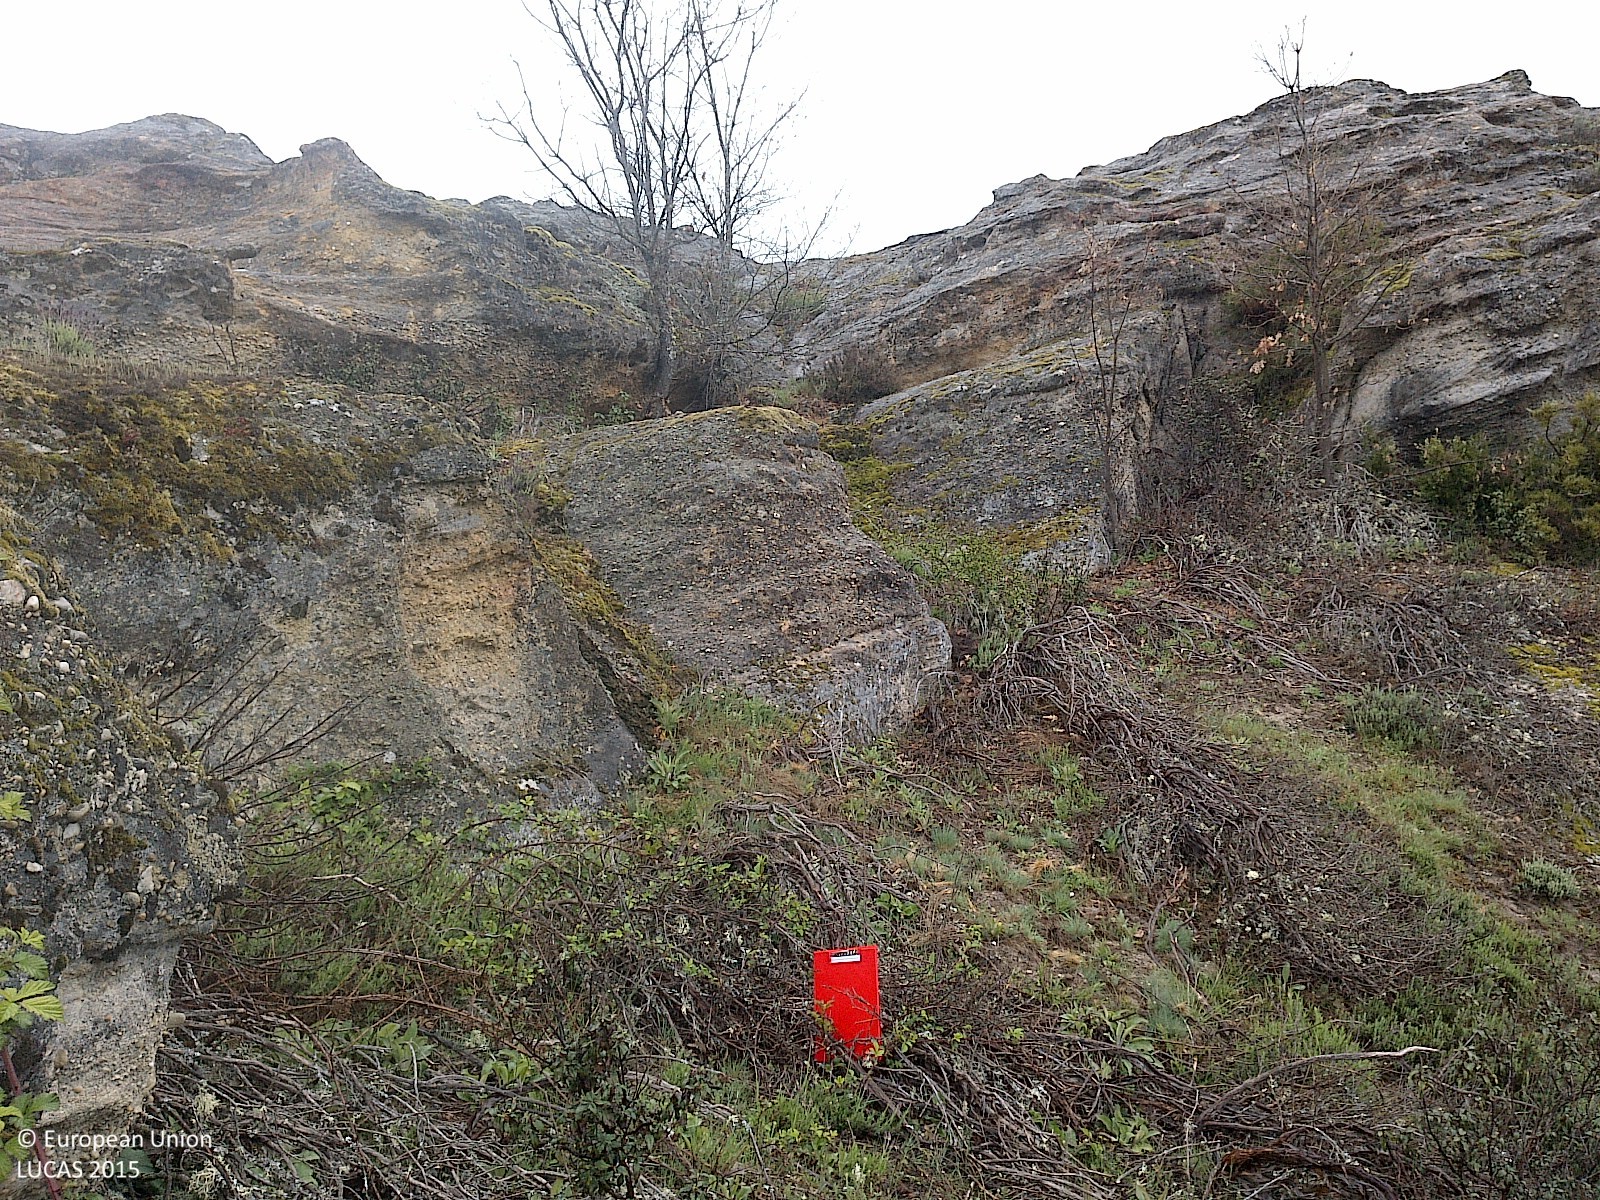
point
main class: Shrubland
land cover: Shrubland with sparse tree cover
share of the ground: 25 - 50 %
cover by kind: consolidated bare surface 55 %, shrubs 25 %, lichens and mosses 10 %, broadleaved forest trees 5 %, herbaceous plants 5 %
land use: Semi-natural and natural areas not in use
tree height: > 5 m
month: May
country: ES
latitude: 41.9136
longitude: -3.2023
